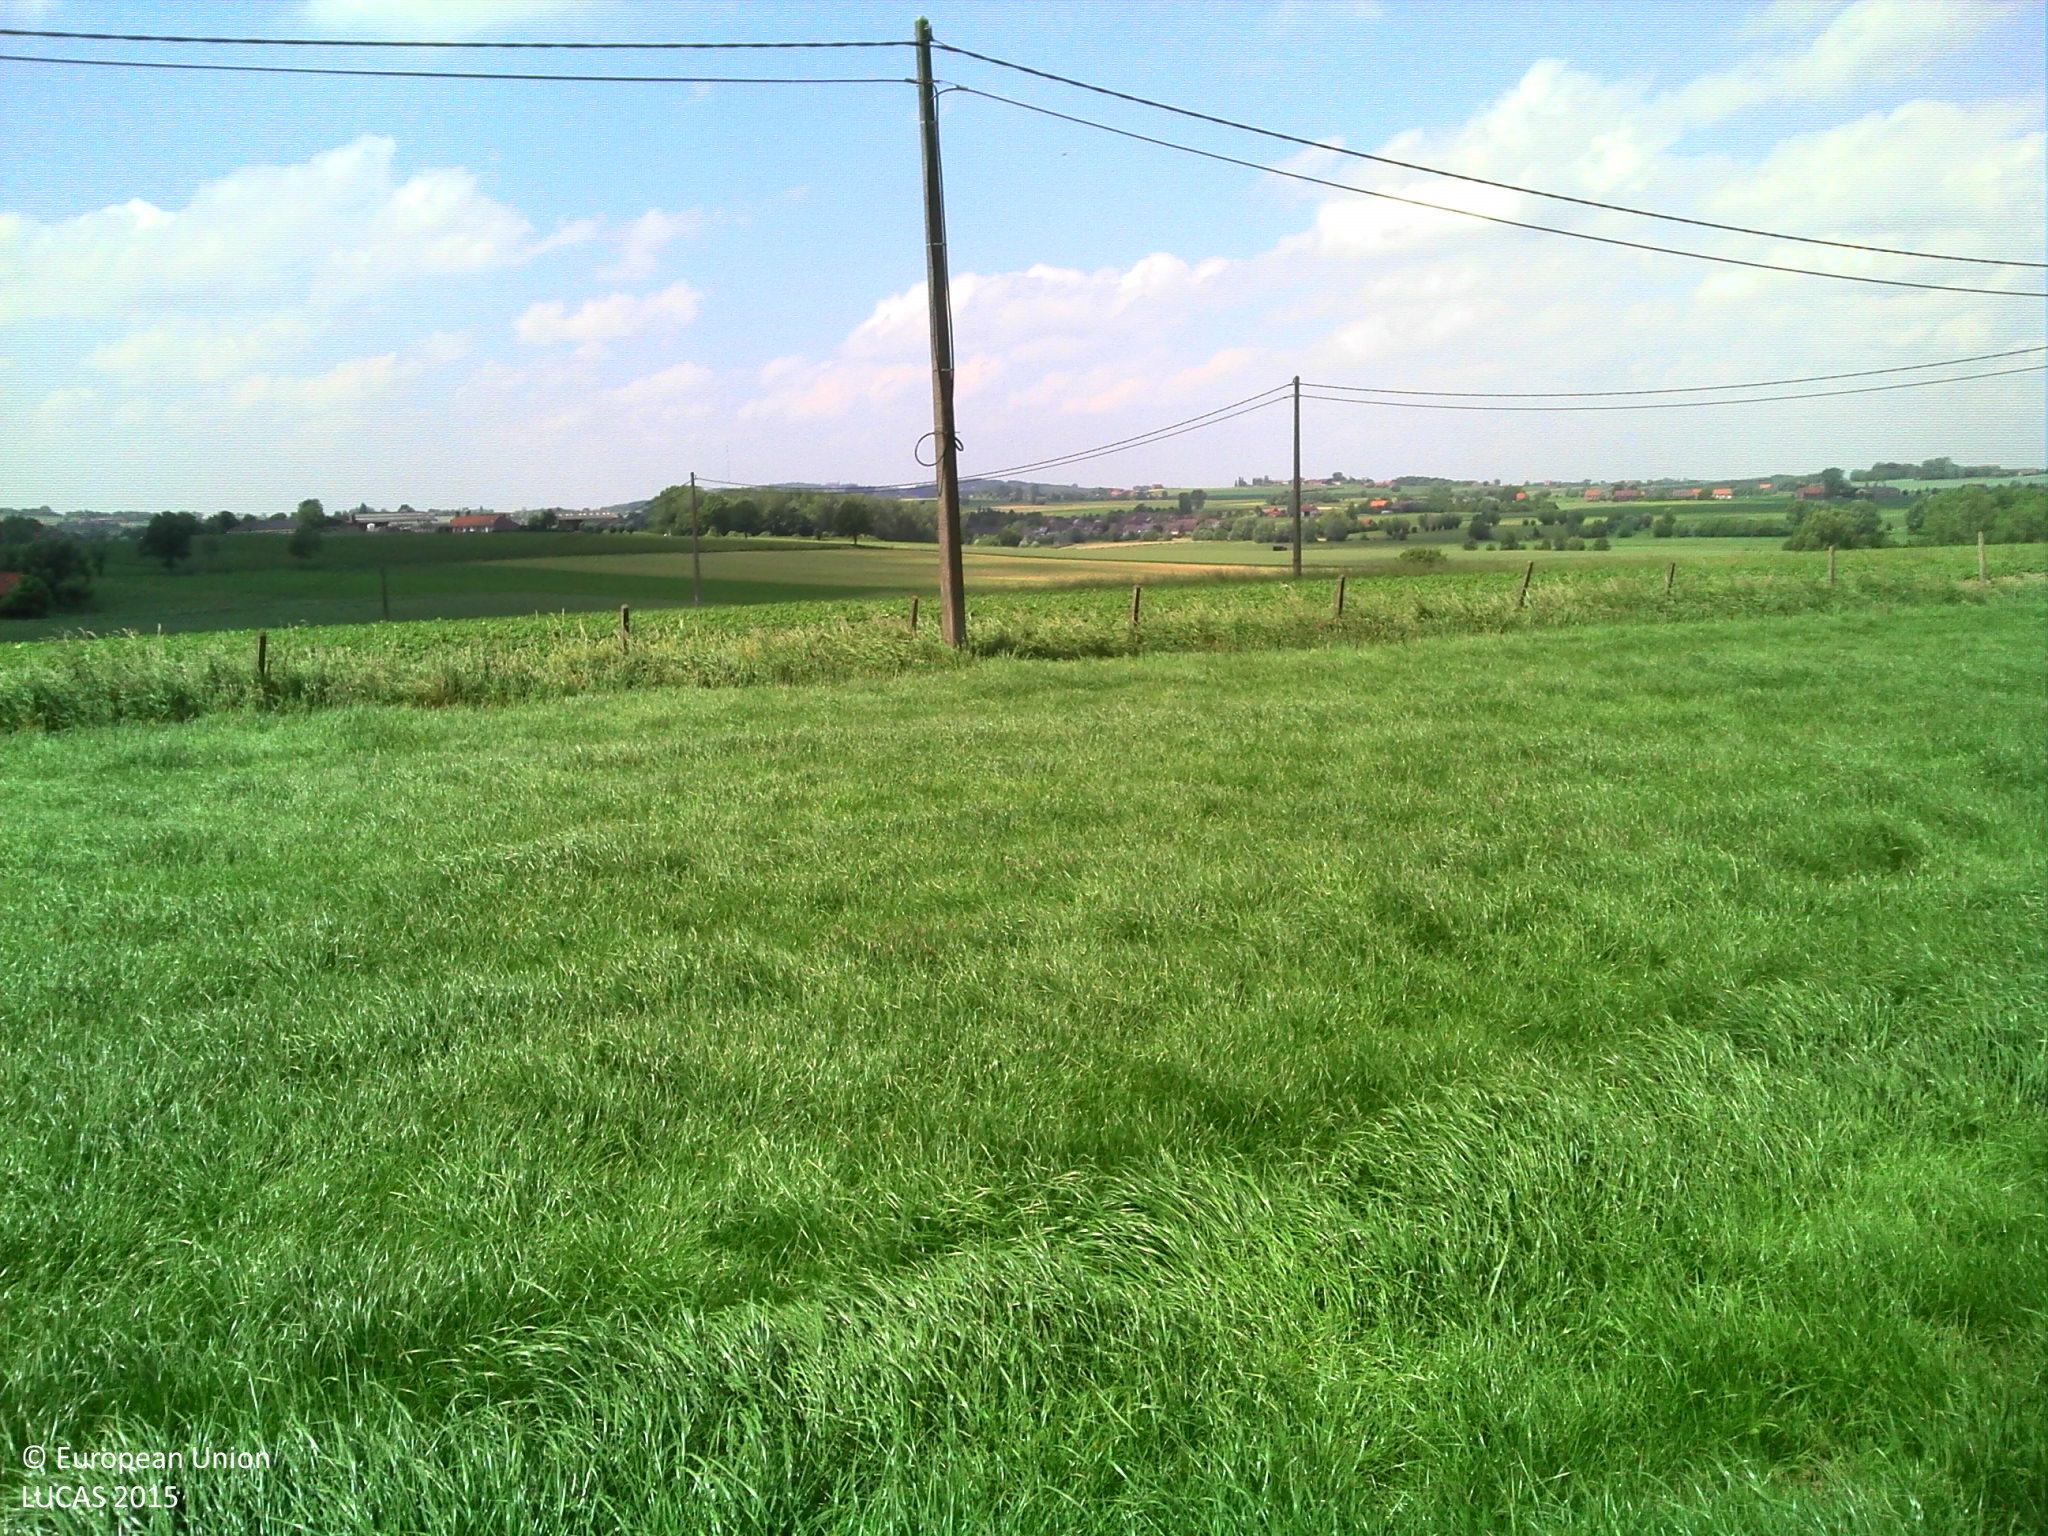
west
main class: Grassland
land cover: Grassland without tree/shrub cover
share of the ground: > 75 %
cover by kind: herbaceous plants 100 %
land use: Agriculture (excluding fallow land and kitchen gardens)
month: June
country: BE
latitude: 50.8029
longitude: 2.7662
